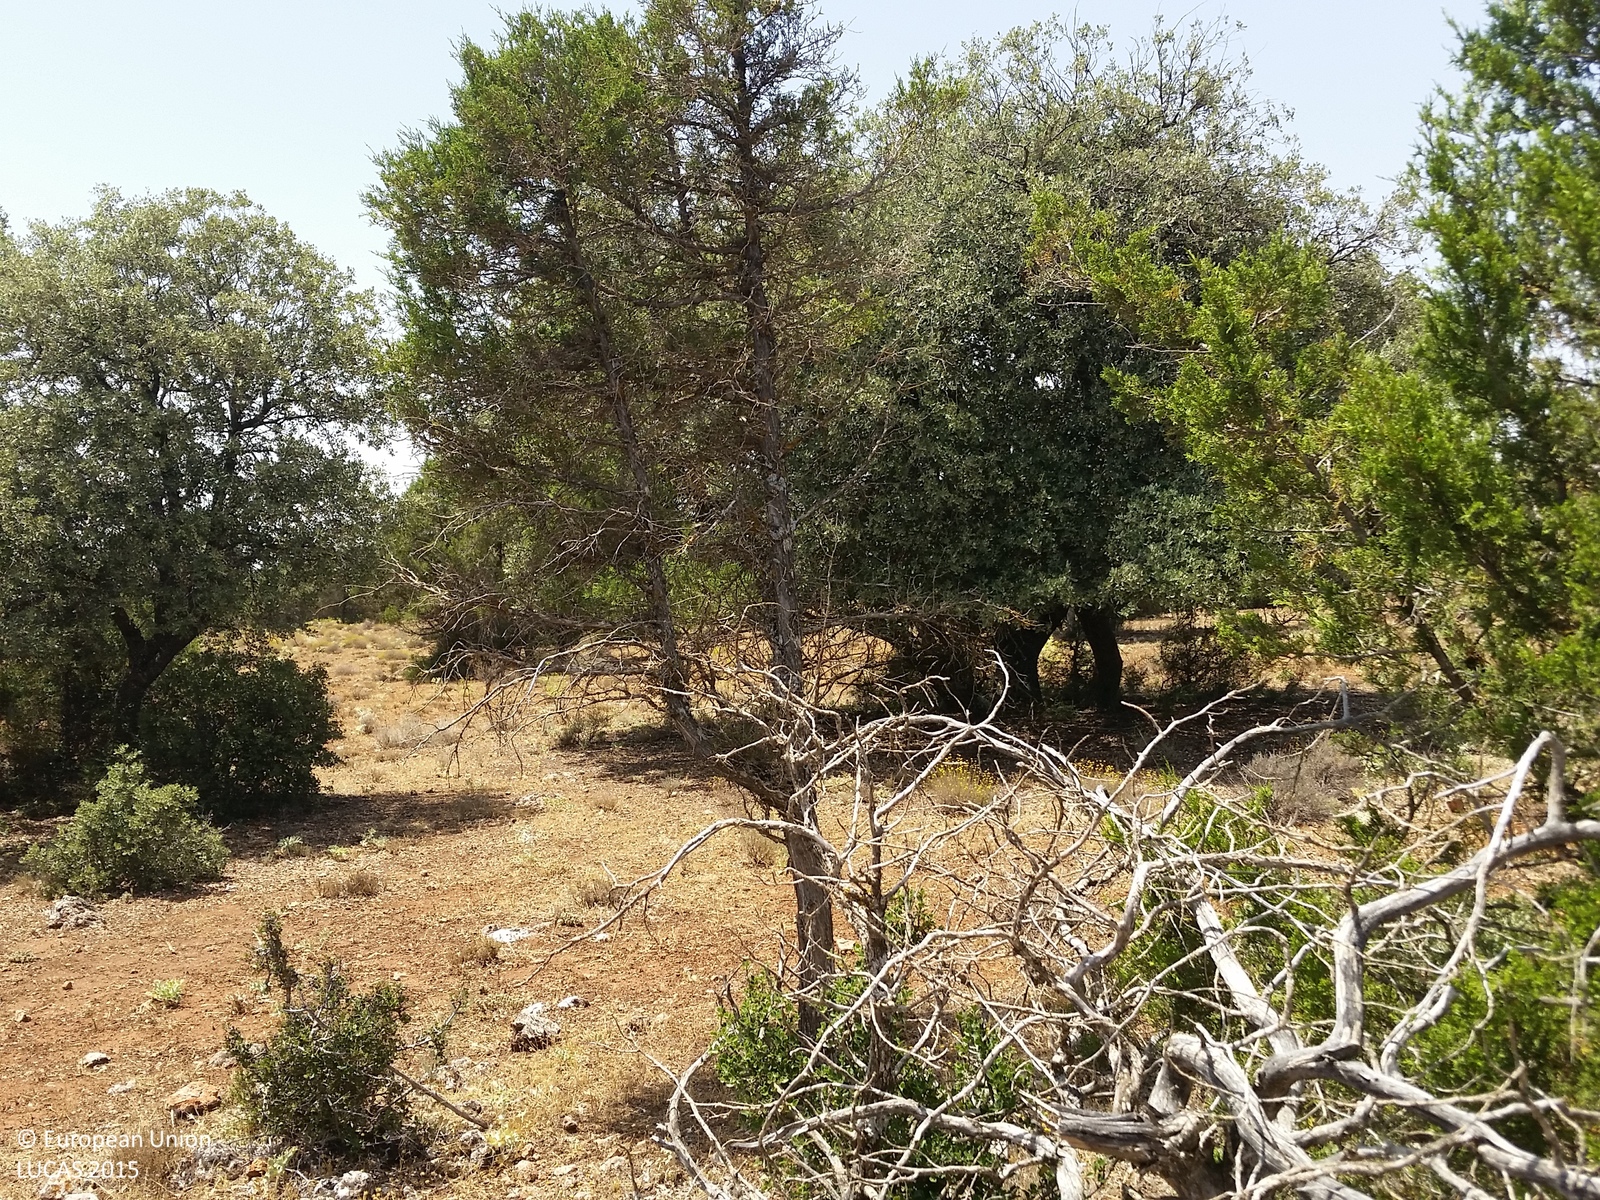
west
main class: Woodland
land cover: Pine dominated mixed woodland
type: coniferous forest of the mediterranean region
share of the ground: > 75 %
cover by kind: shrubs 30 %, coniferous forest trees 25 %, herbaceous plants 20 %, broadleaved forest trees 15 %, consolidated bare surface 10 %
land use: Semi-natural and natural areas not in use
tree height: > 5 m
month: June
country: ES
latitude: 38.8062
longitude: -2.4972
